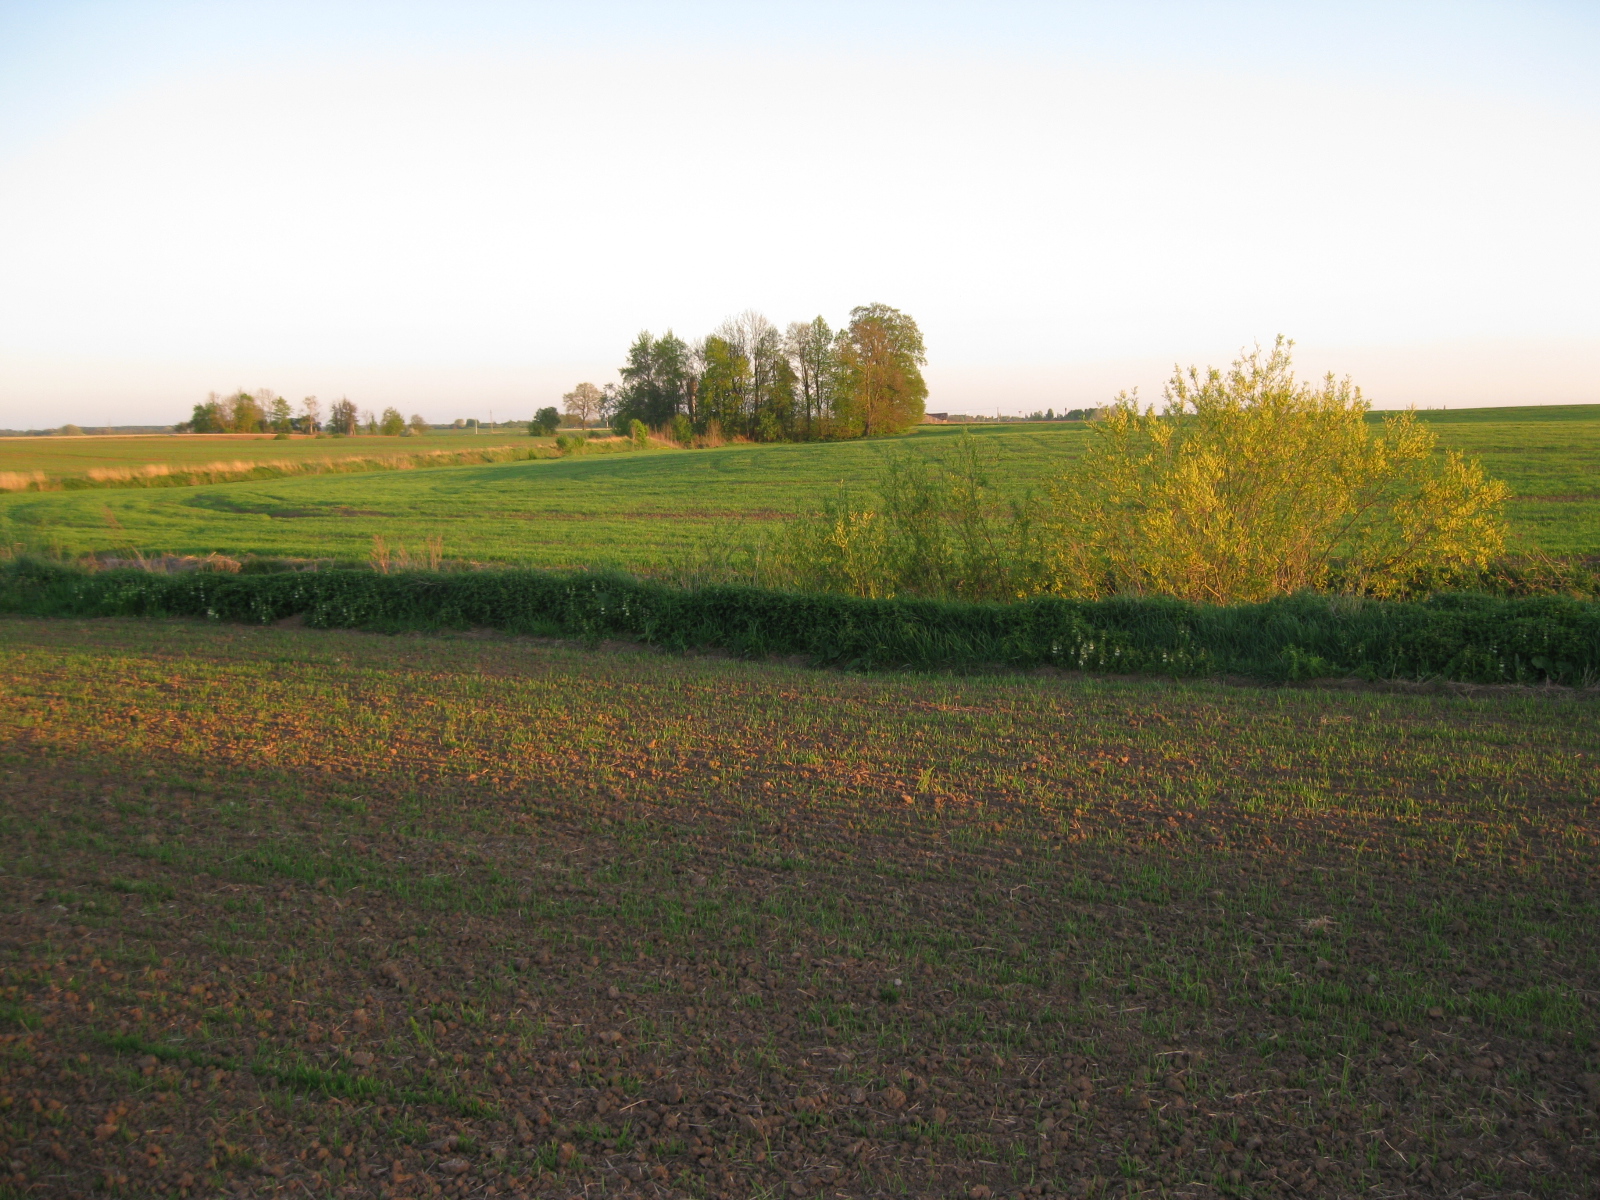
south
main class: Cropland
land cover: Common wheat
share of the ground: < 10 %
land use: Agriculture (excluding fallow land and kitchen gardens)
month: May
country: LT
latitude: 56.1168
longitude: 24.4263
